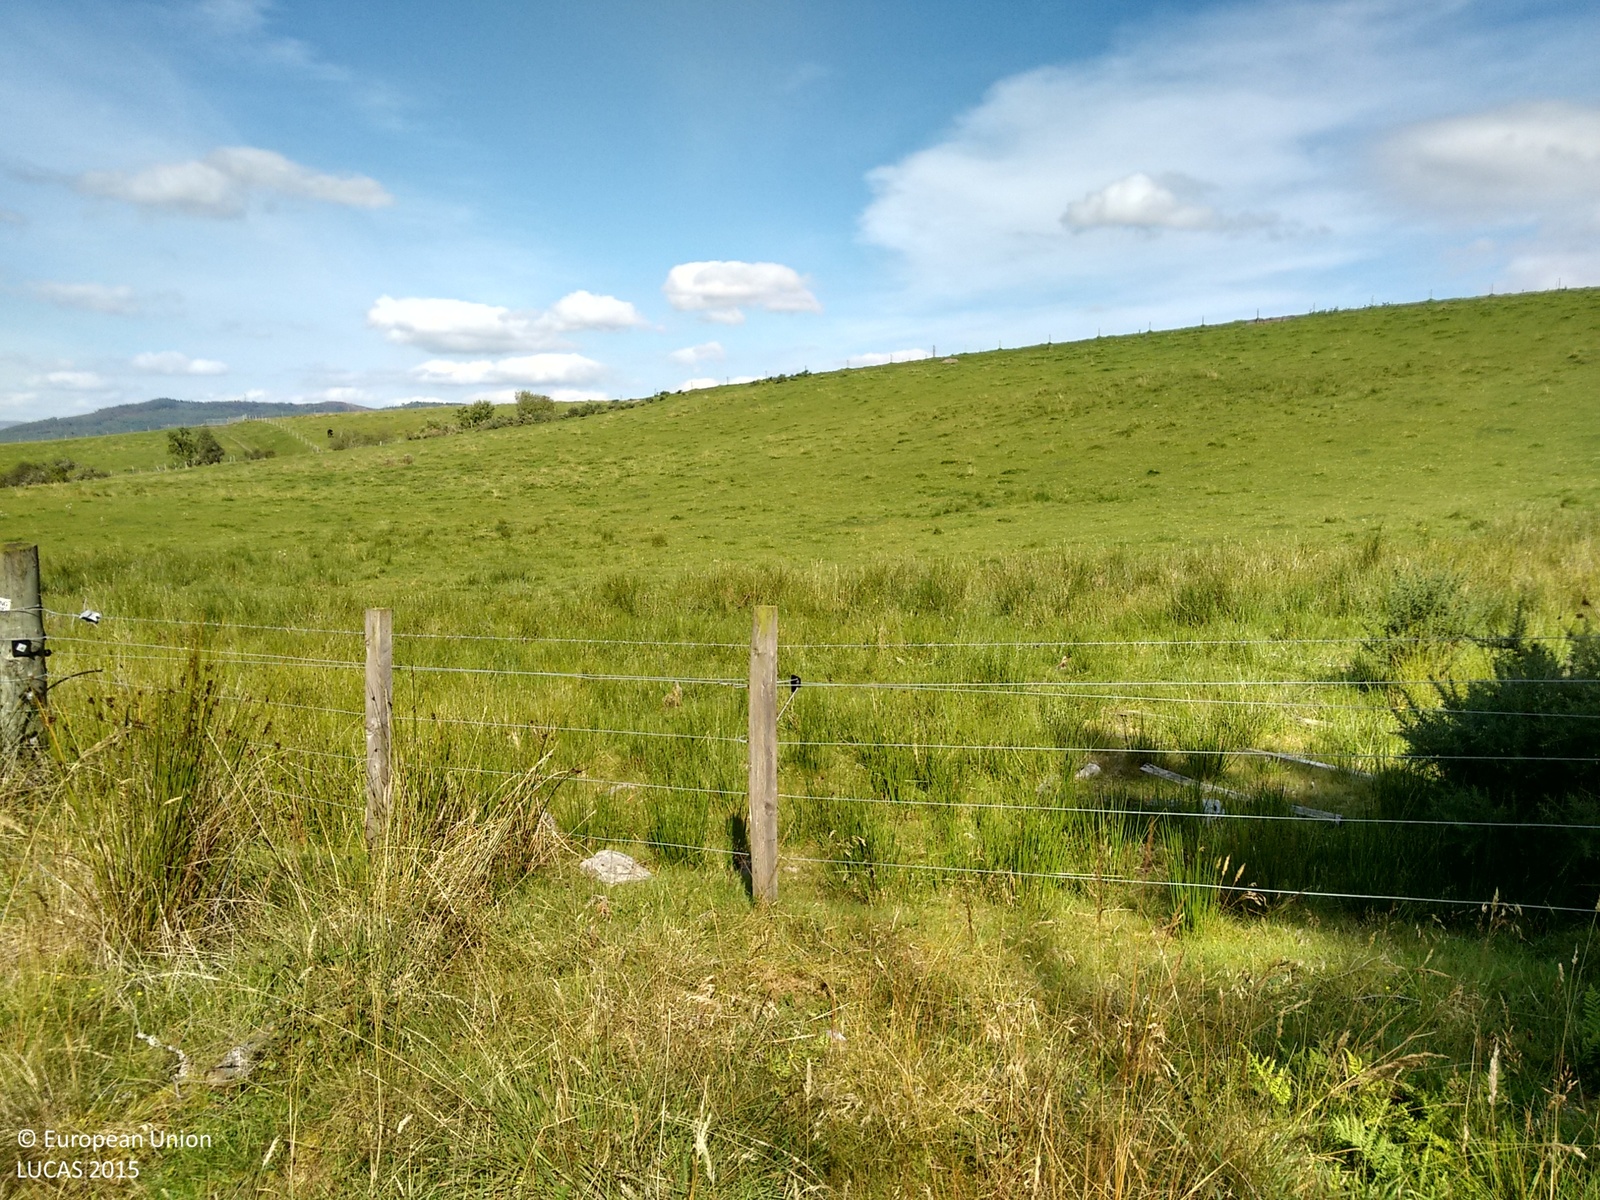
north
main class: Woodland
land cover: Pine dominated coniferous woodland
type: exotic forest
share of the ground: > 75 %
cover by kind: coniferous forest trees 80 %, shrubs 10 %, herbaceous plants 10 %
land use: Forestry
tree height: > 5 m
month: September
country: GB
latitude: 57.8848
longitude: -4.3363
